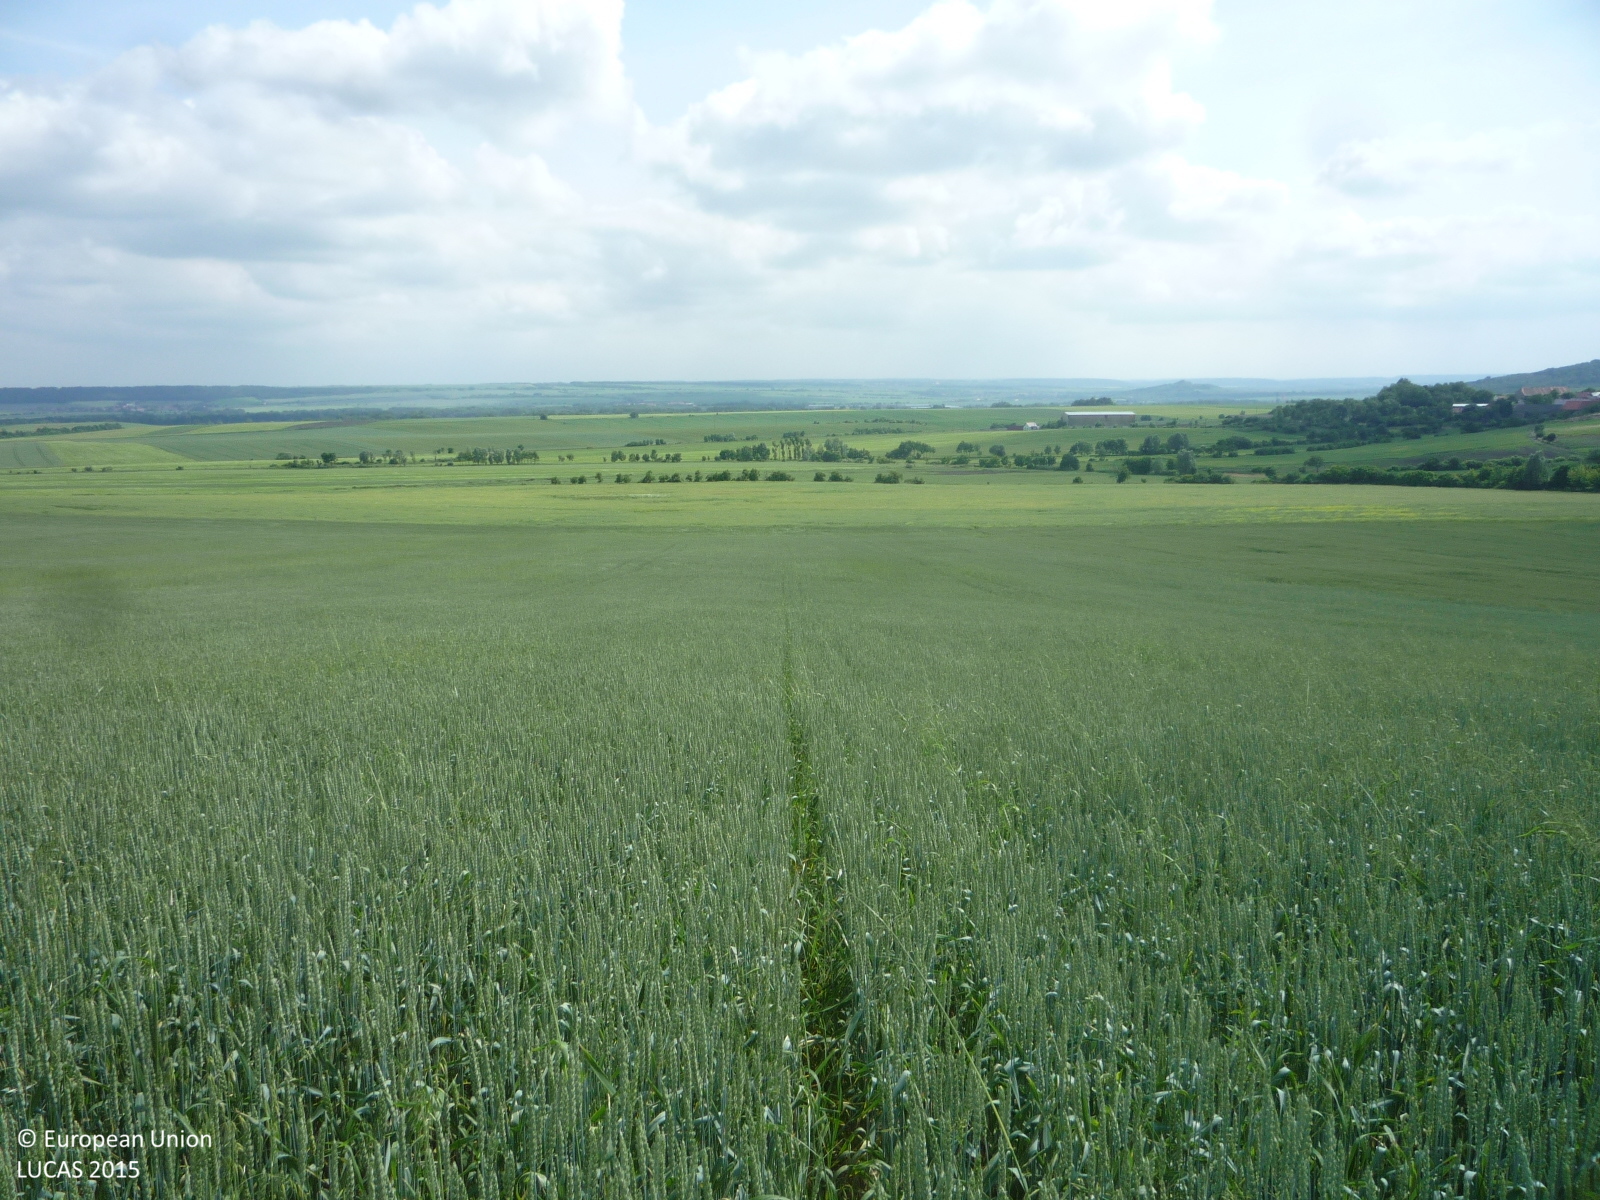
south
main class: Cropland
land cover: Common wheat
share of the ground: > 75 %
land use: Agriculture (excluding fallow land and kitchen gardens)
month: June
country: CZ
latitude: 50.4066
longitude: 13.8702
